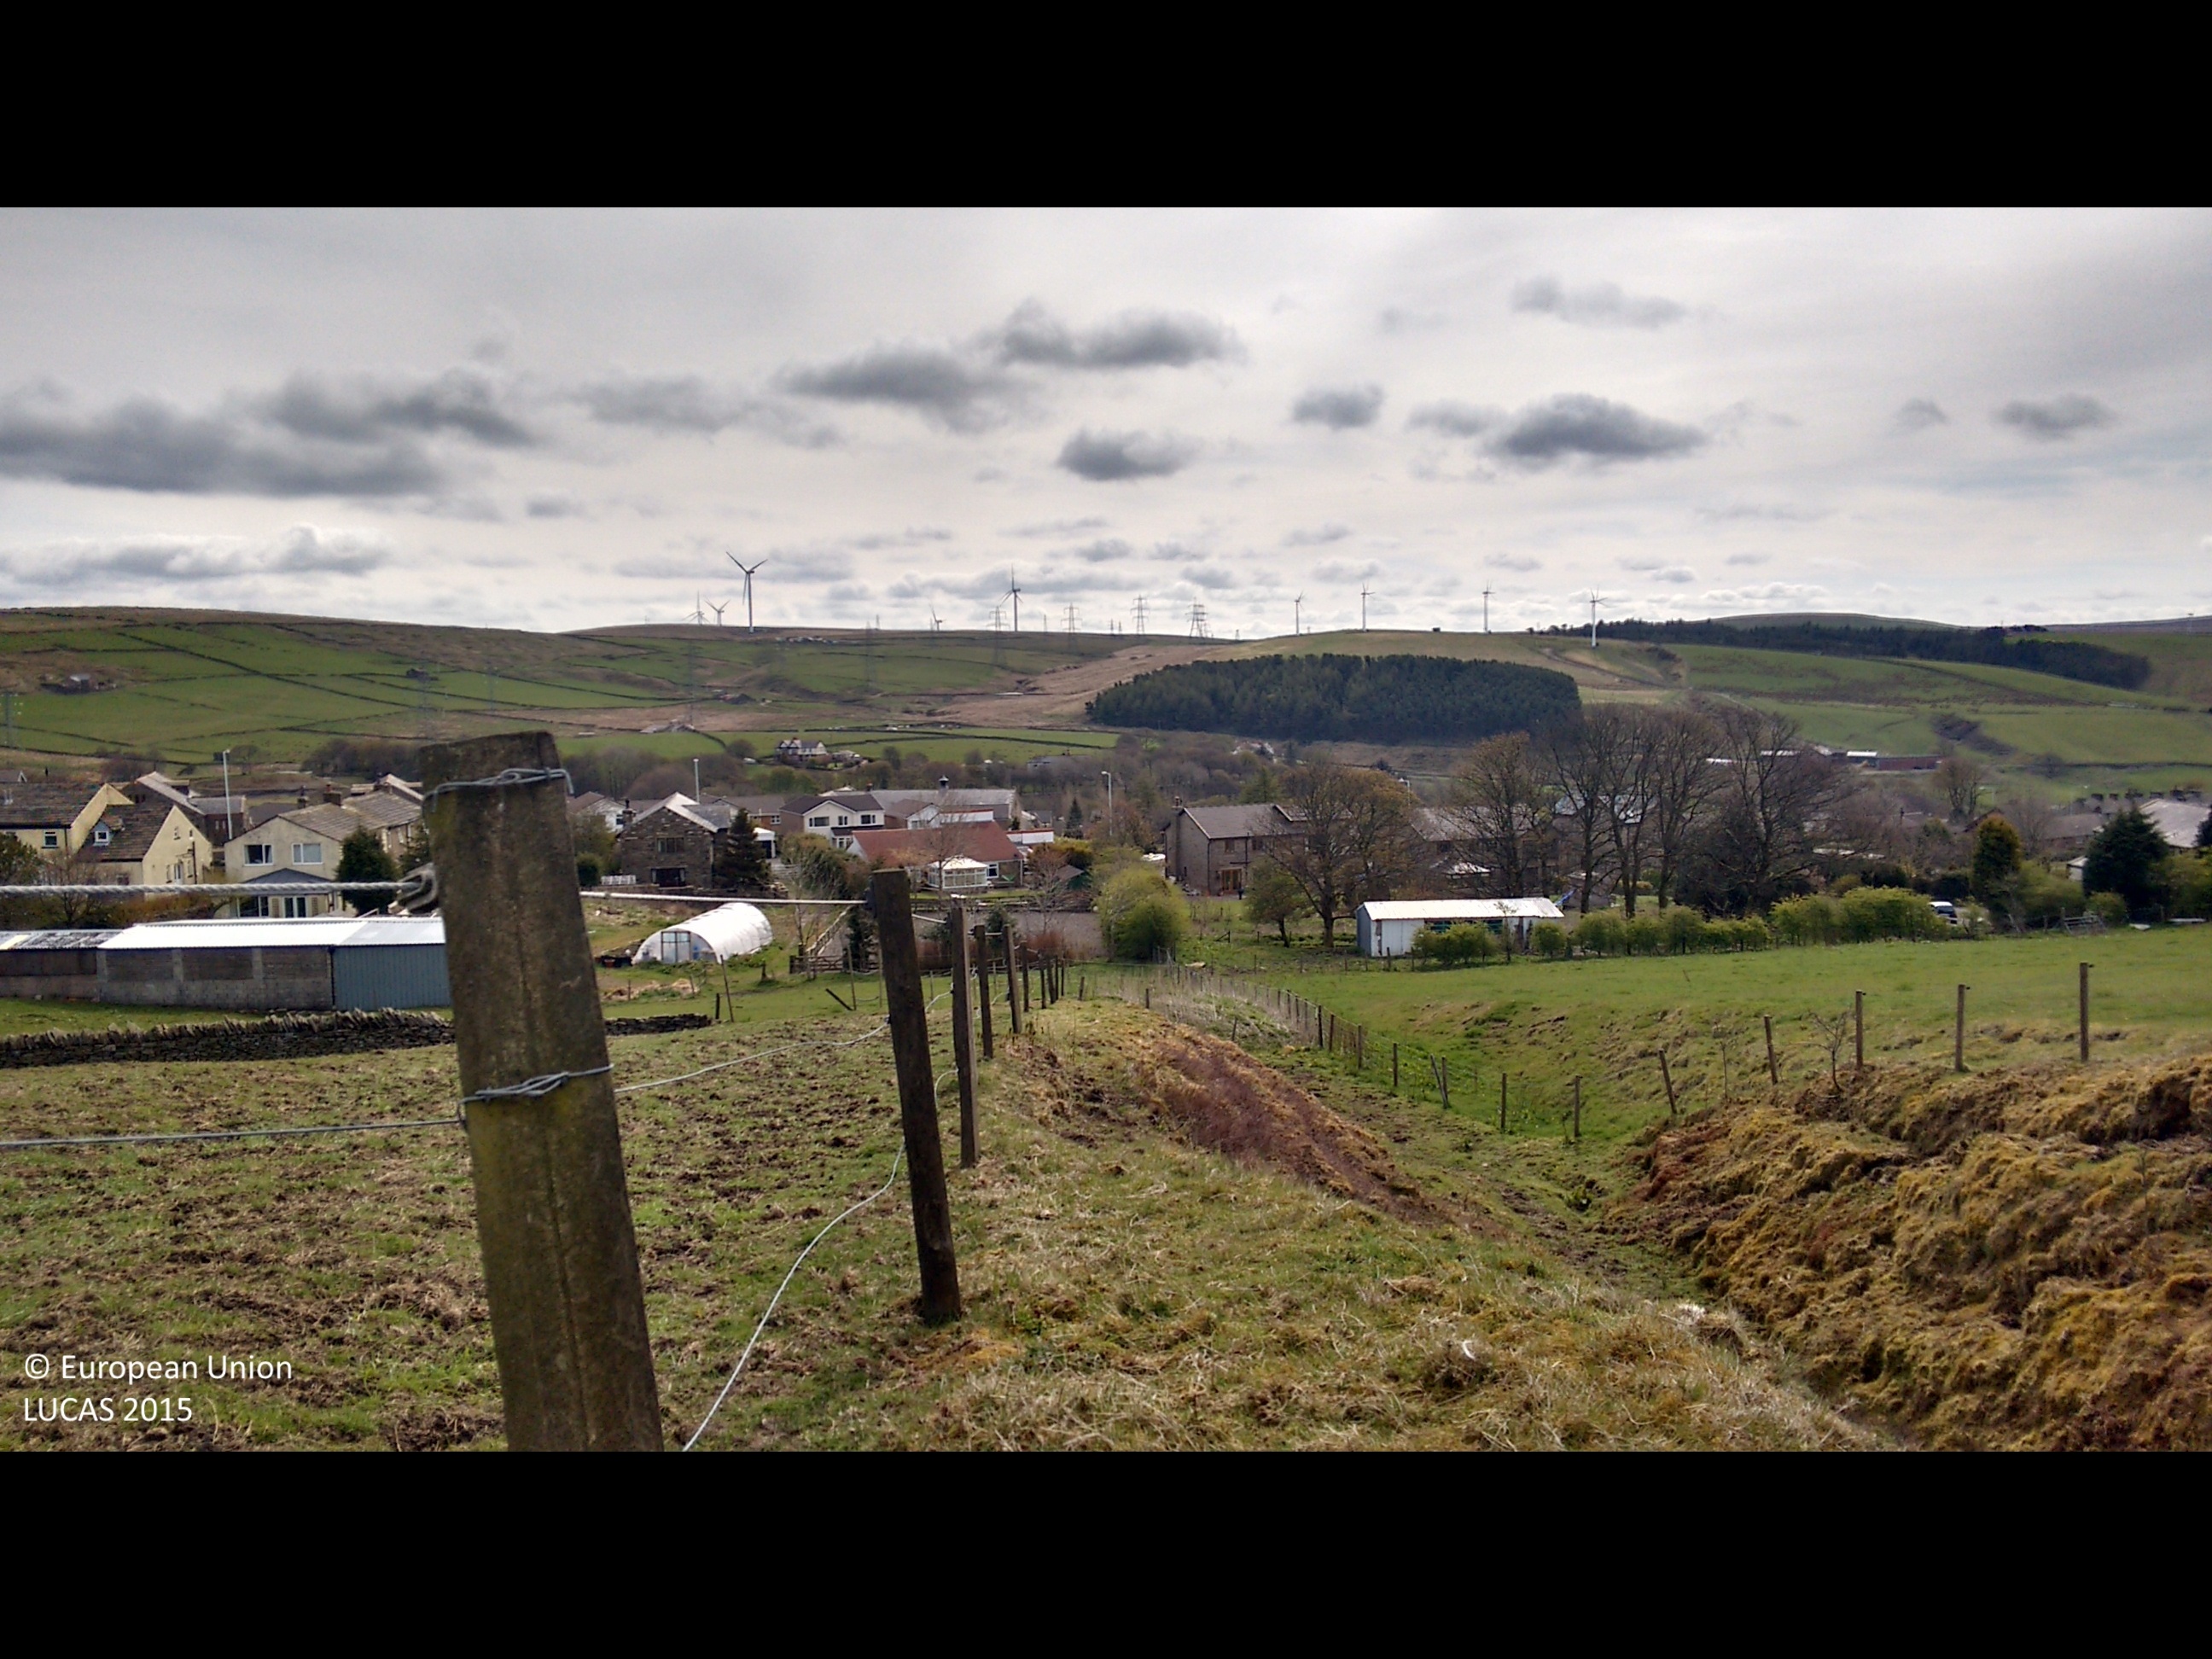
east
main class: Grassland
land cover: Grassland without tree/shrub cover
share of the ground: > 75 %
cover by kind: herbaceous plants 100 %
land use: Agriculture (excluding fallow land and kitchen gardens)
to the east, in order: Grassland without tree/shrub cover; Dry stone walls; Grassland without tree/shrub cover; Artificial constructions in urban areas
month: May
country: GB
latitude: 53.7282
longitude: -2.2011
